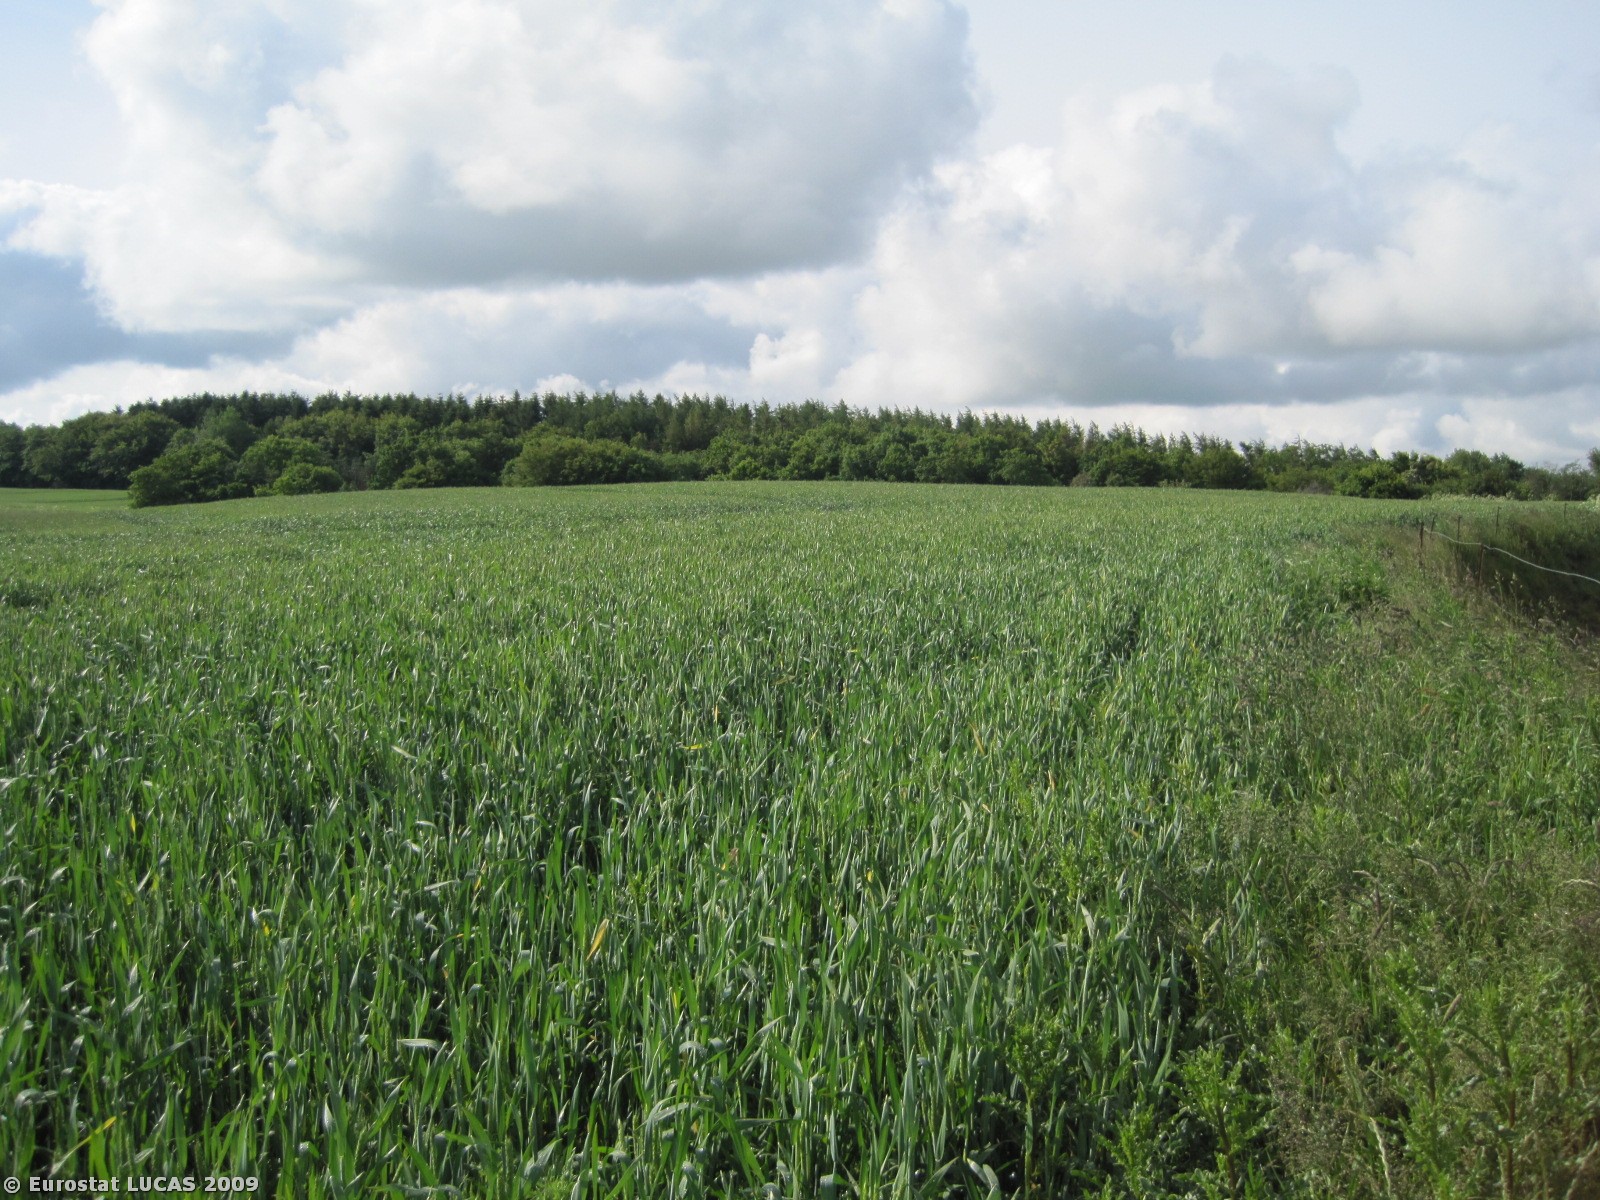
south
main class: Grassland
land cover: Grassland without tree/shrub cover
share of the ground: > 75 %
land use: Agriculture (excluding fallow land and kitchen gardens)
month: June
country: DK
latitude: 57.3023
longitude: 10.1491
